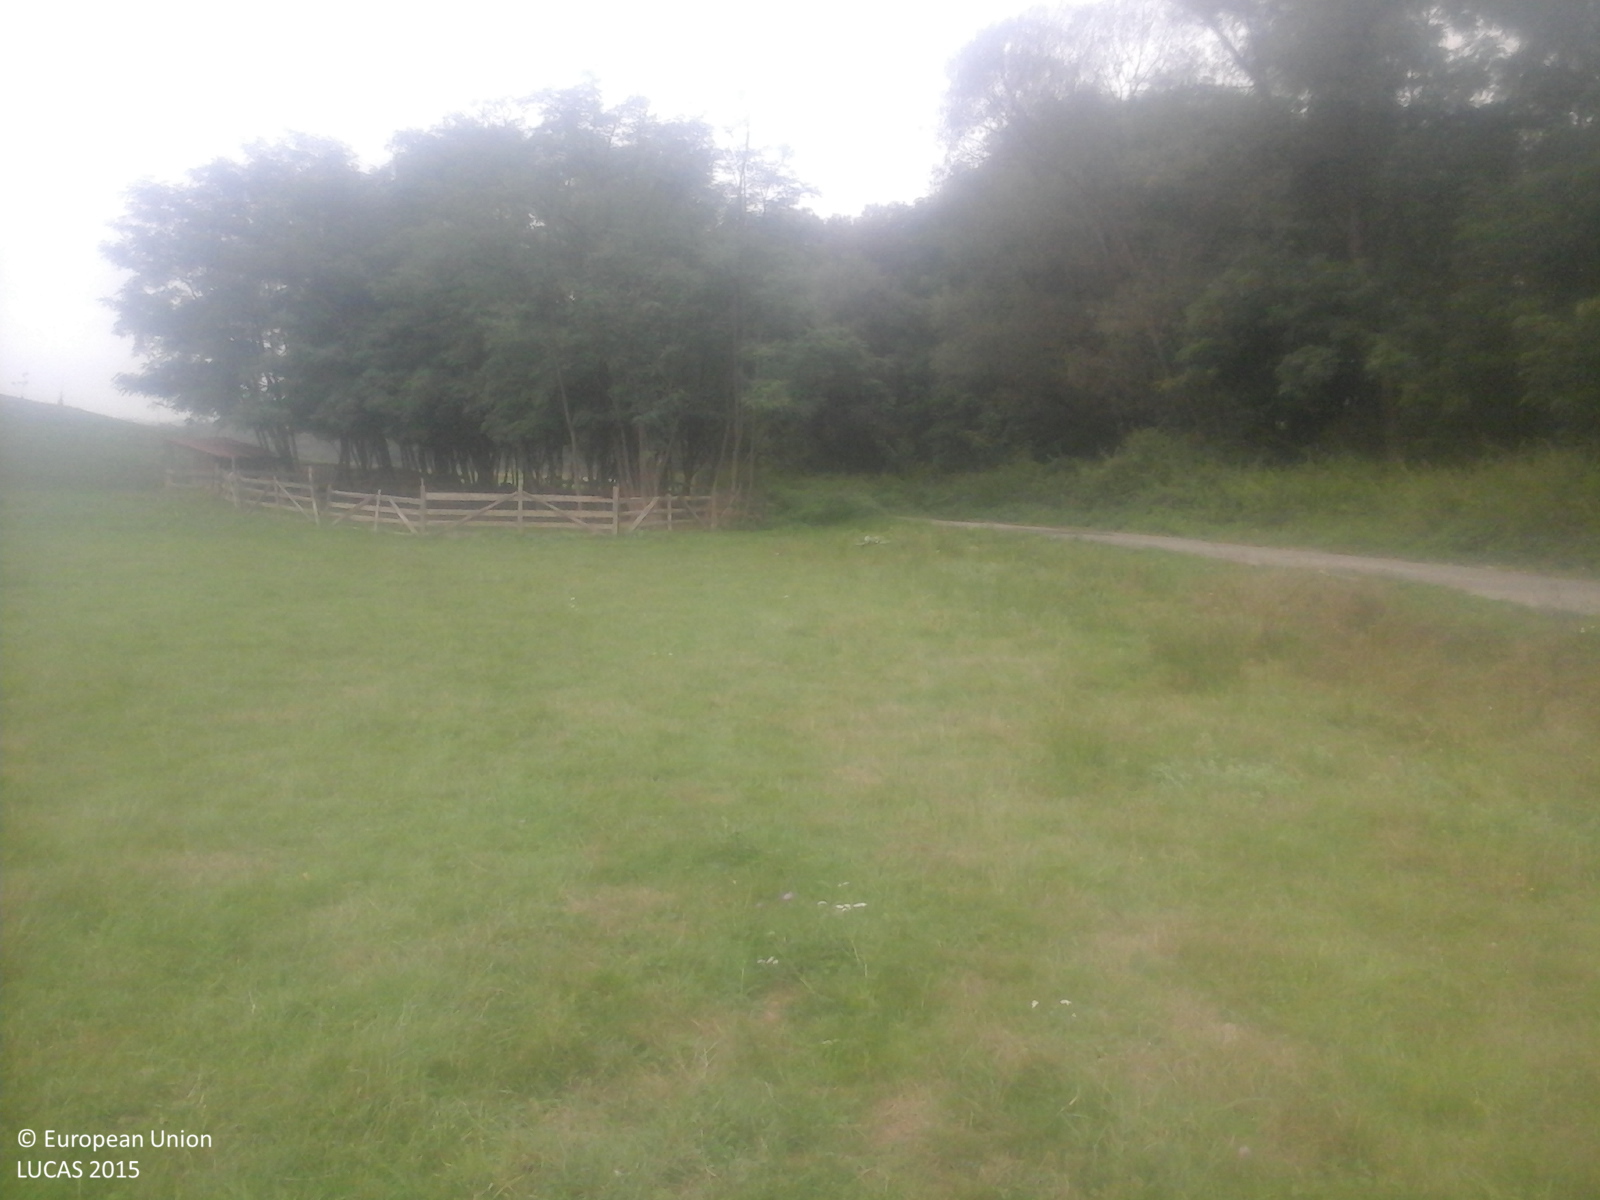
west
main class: Grassland
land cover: Grassland without tree/shrub cover
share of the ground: > 75 %
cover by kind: herbaceous plants 100 %
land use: Agriculture (excluding fallow land and kitchen gardens)
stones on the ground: < 10 %
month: September
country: RO
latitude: 45.5348
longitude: 21.9342
